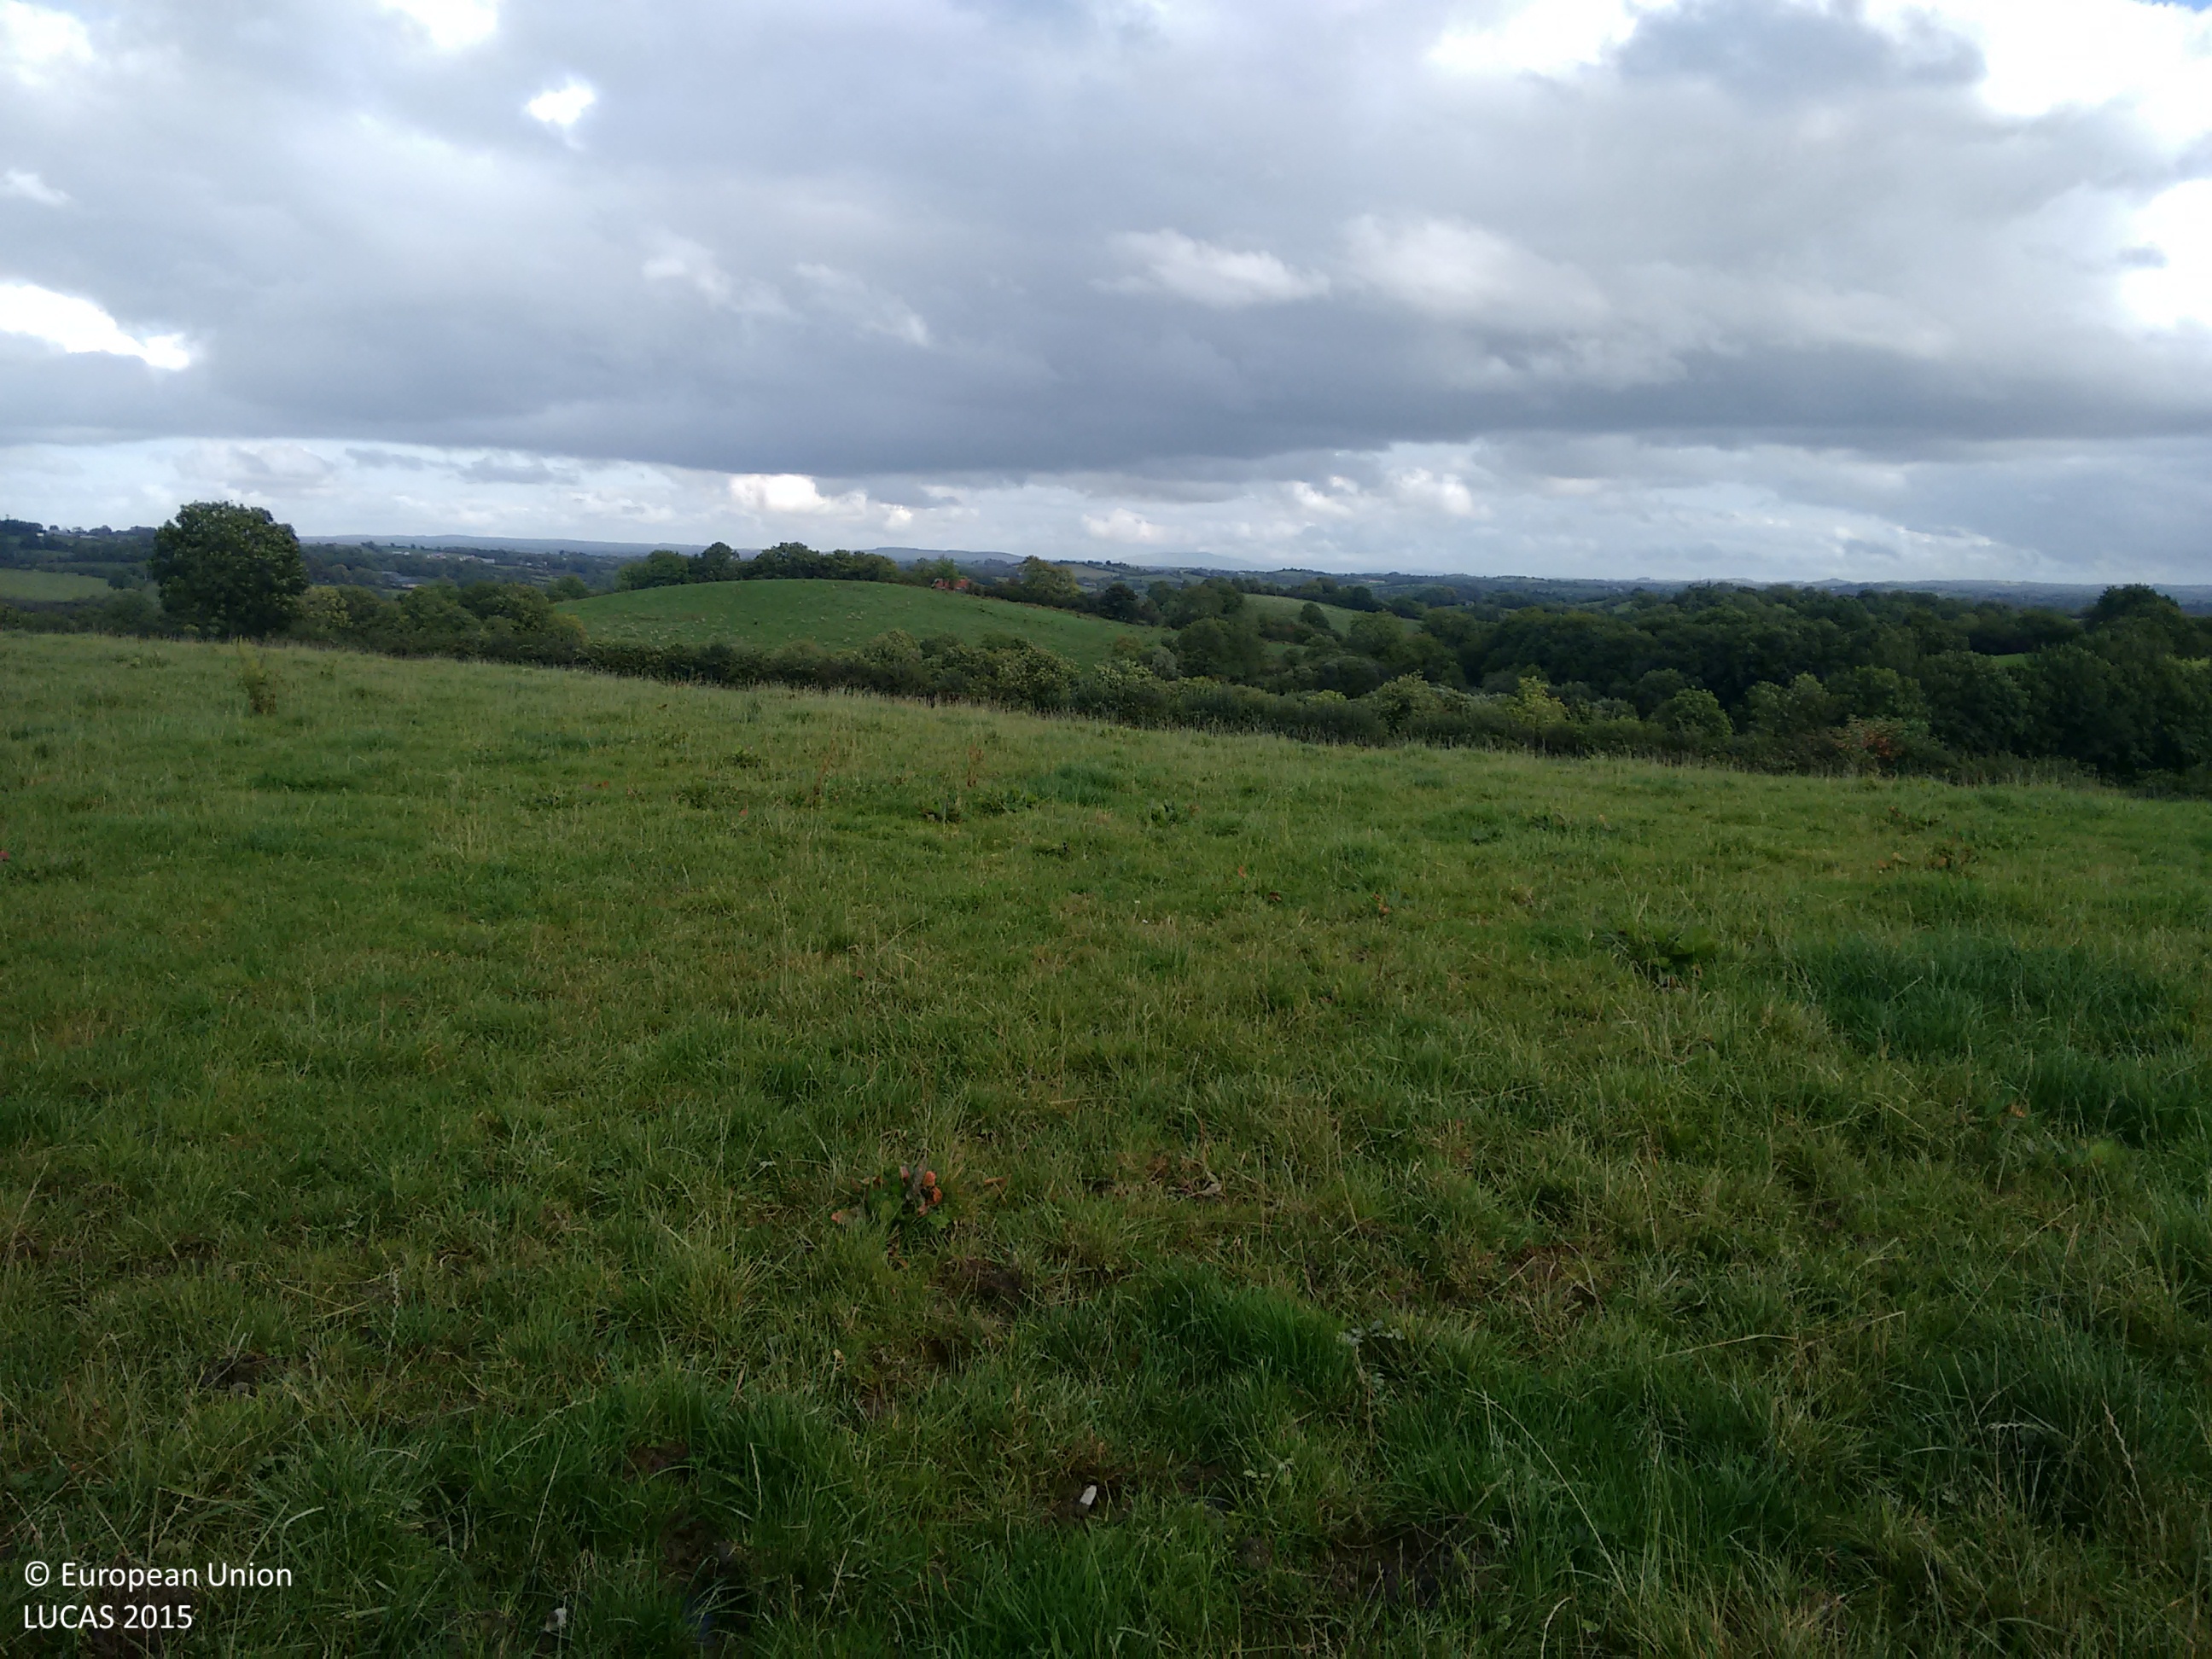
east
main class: Grassland
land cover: Grassland without tree/shrub cover
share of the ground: > 75 %
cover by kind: herbaceous plants 100 %
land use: Agriculture (excluding fallow land and kitchen gardens)
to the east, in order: Grassland without tree/shrub cover; Fences; Managed hedges; Grassland without tree/shrub cover; Fences; Abandoned hedges; Fences; Grassland without tree/shrub cover
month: September
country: IE
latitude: 54.1778
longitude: -6.9776
